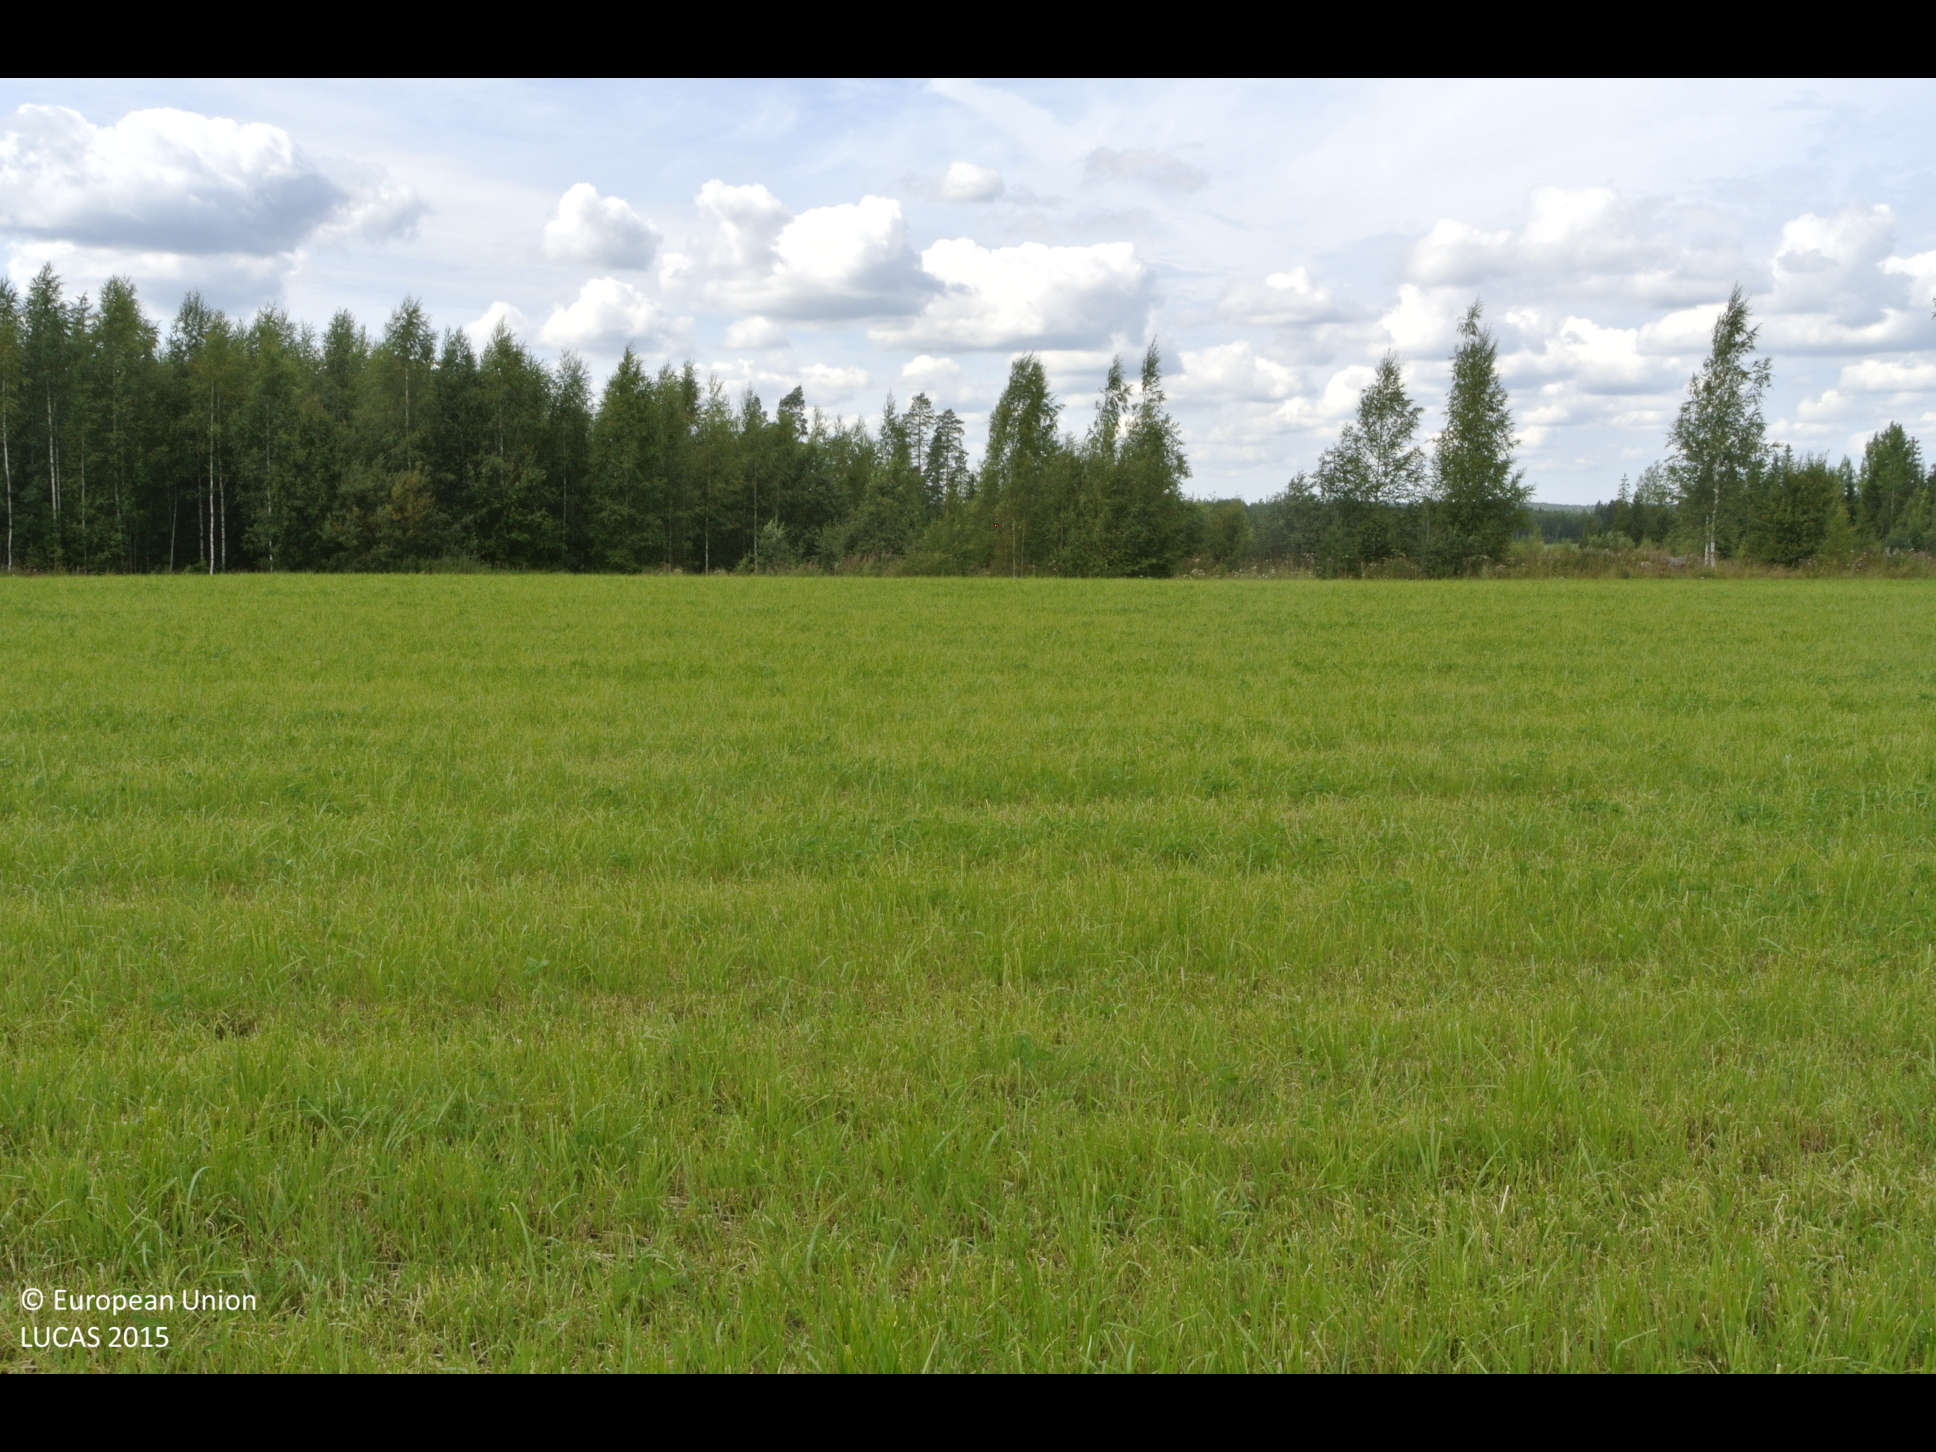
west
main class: Cropland
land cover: Temporary grasslands
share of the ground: > 75 %
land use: Agriculture (excluding fallow land and kitchen gardens)
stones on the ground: 10 - 25 %
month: August
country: FI
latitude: 60.8273
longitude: 25.4829
